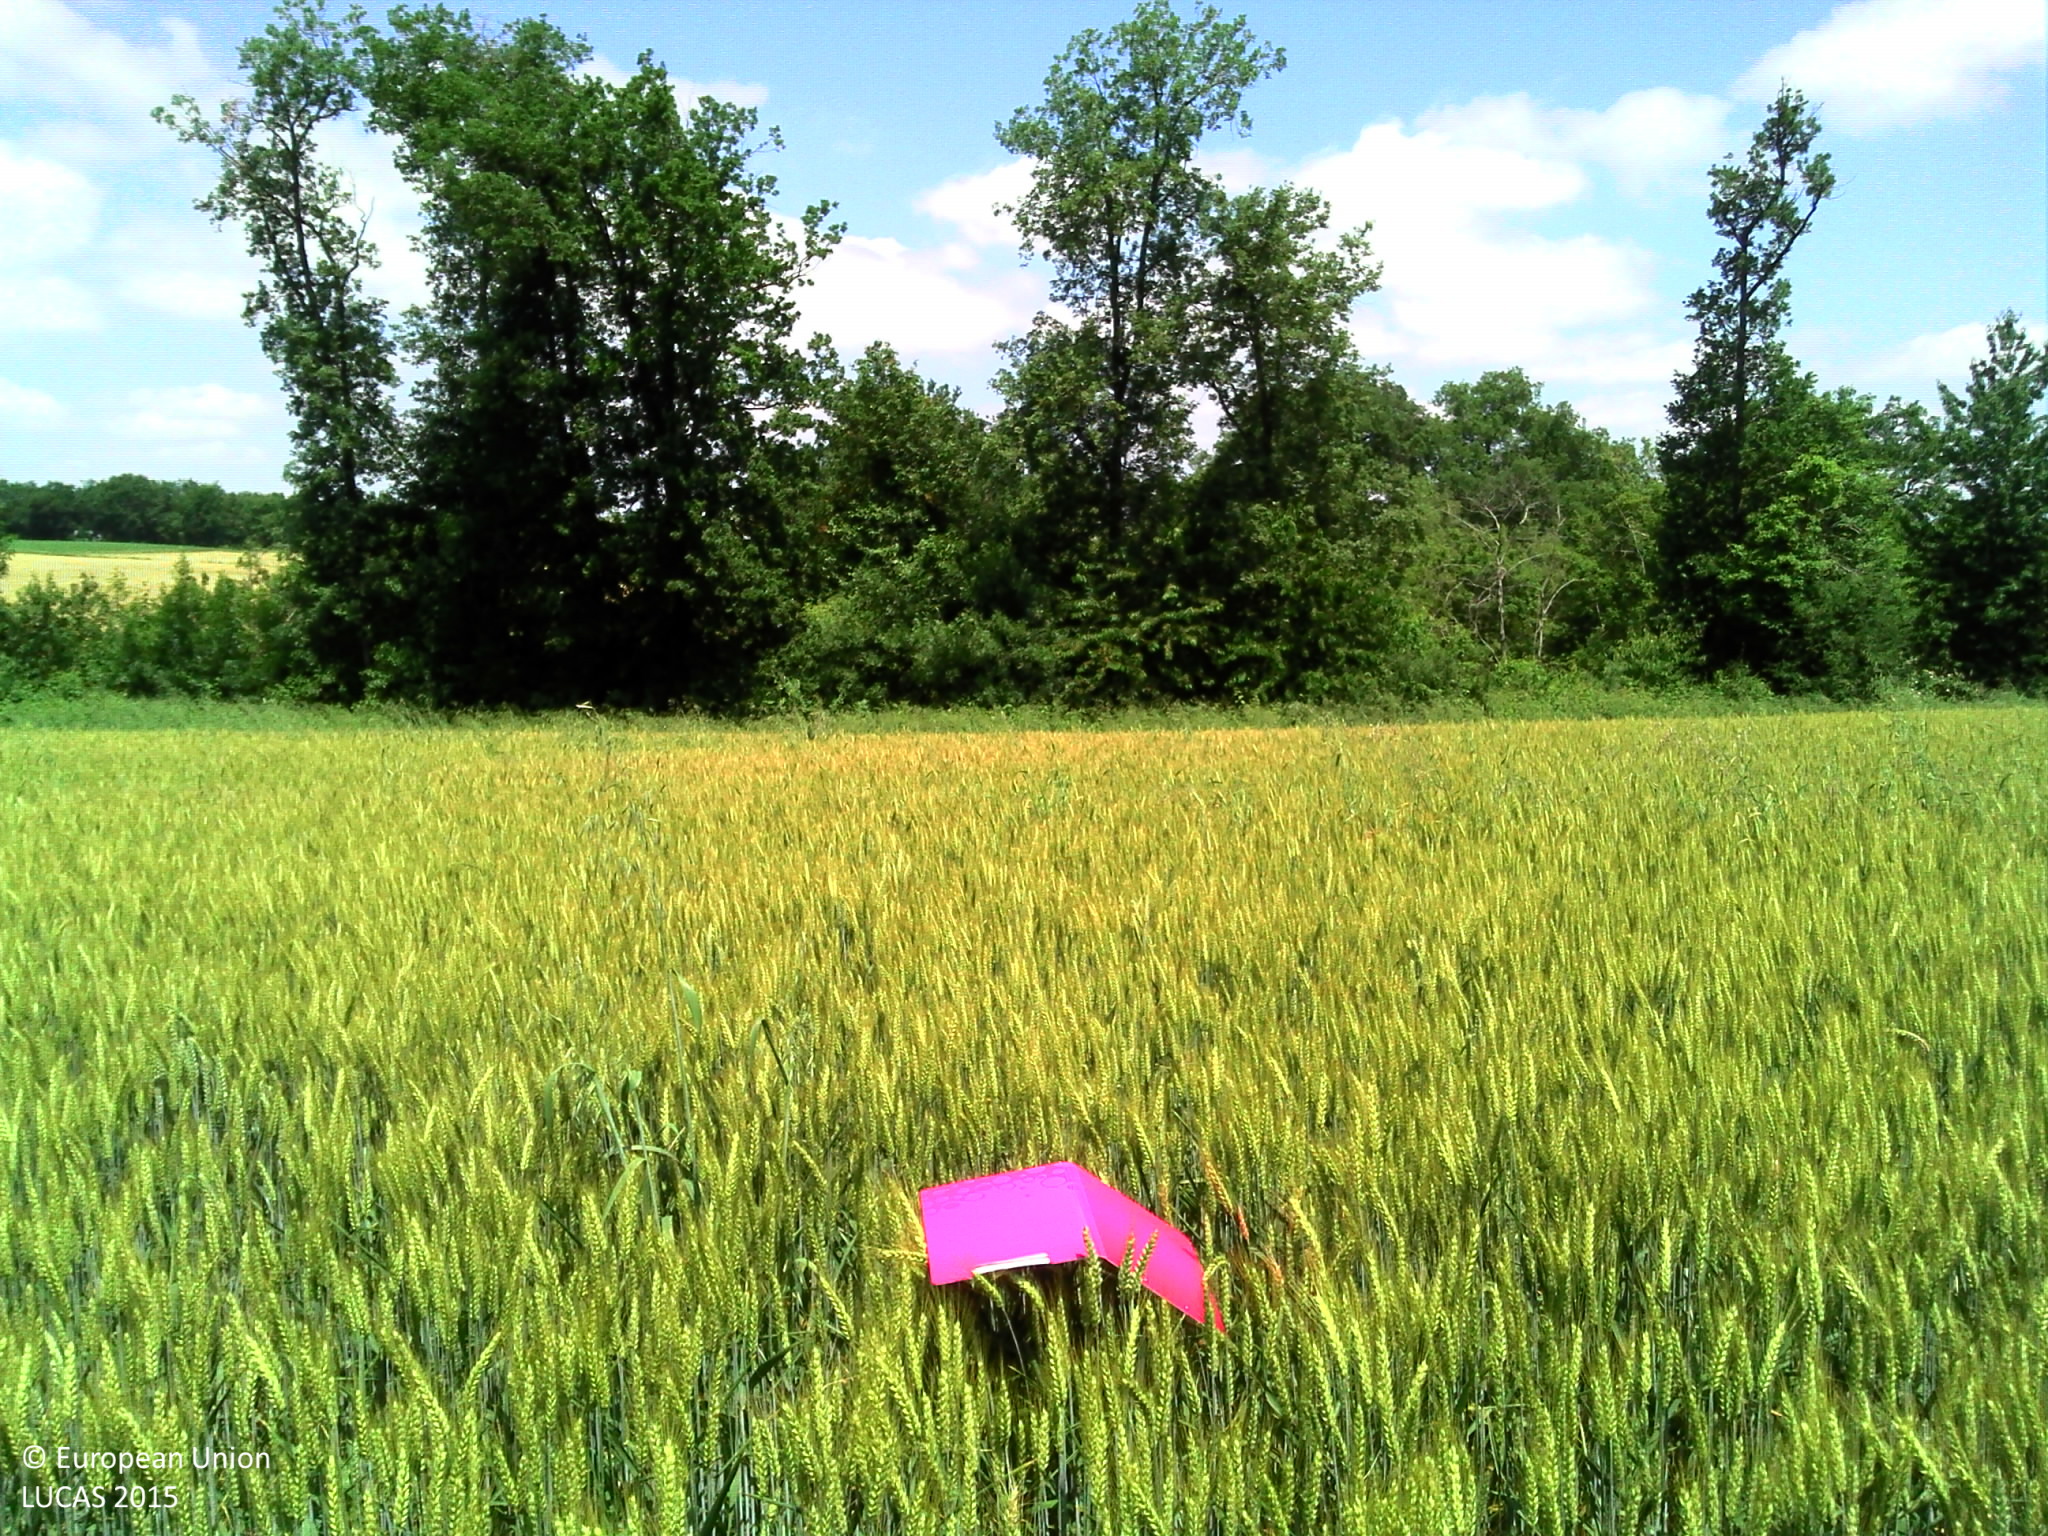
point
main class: Cropland
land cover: Common wheat
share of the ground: > 75 %
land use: Agriculture (excluding fallow land and kitchen gardens)
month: June
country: FR
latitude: 43.6295
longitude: 0.7653
